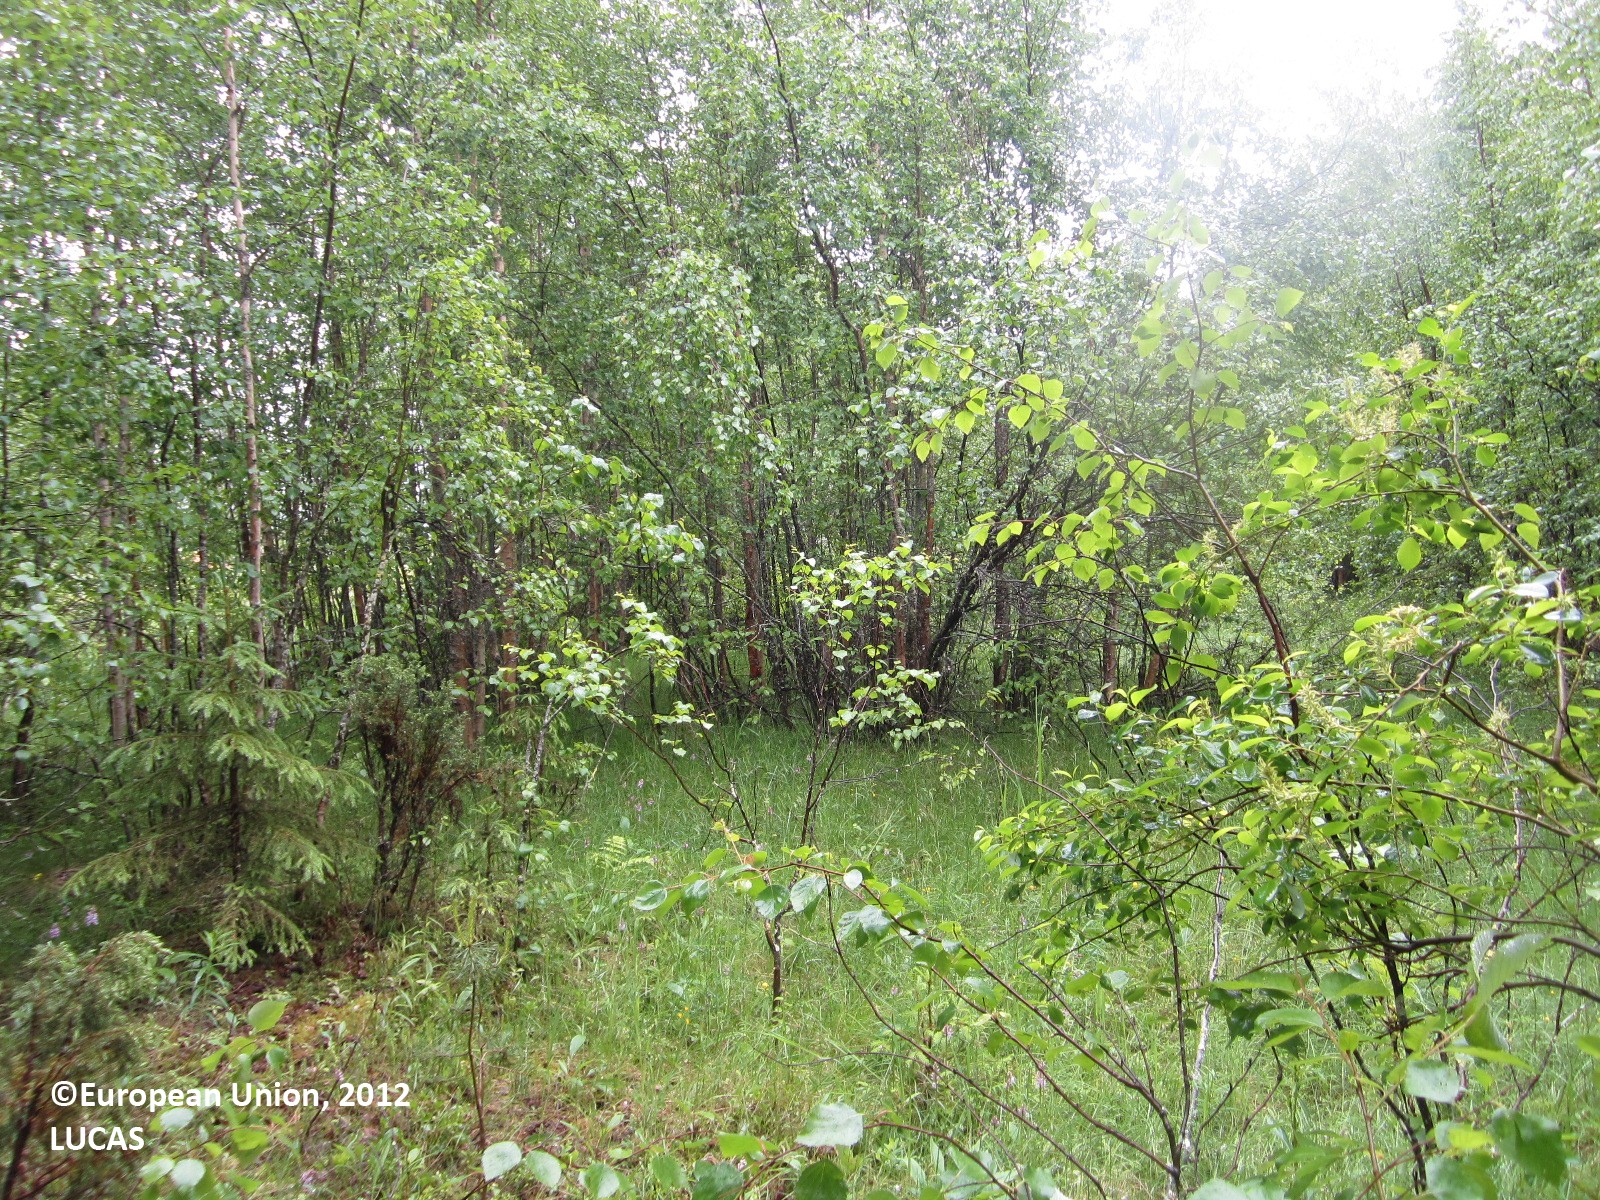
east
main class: Woodland
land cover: Spruce dominated mixed woodland
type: boreal forest
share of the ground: 50 - 75 %
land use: Forestry
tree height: > 5 m
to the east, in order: Spruce dominated mixed woodland; Spontaneously vegetated surfaces; Single bushes/trees; Spontaneously vegetated surfaces; Grass margins; Potatoes; Grassland without tree/shrub cover; Spontaneously vegetated surfaces
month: June
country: FI
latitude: 64.6120
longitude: 29.9423
